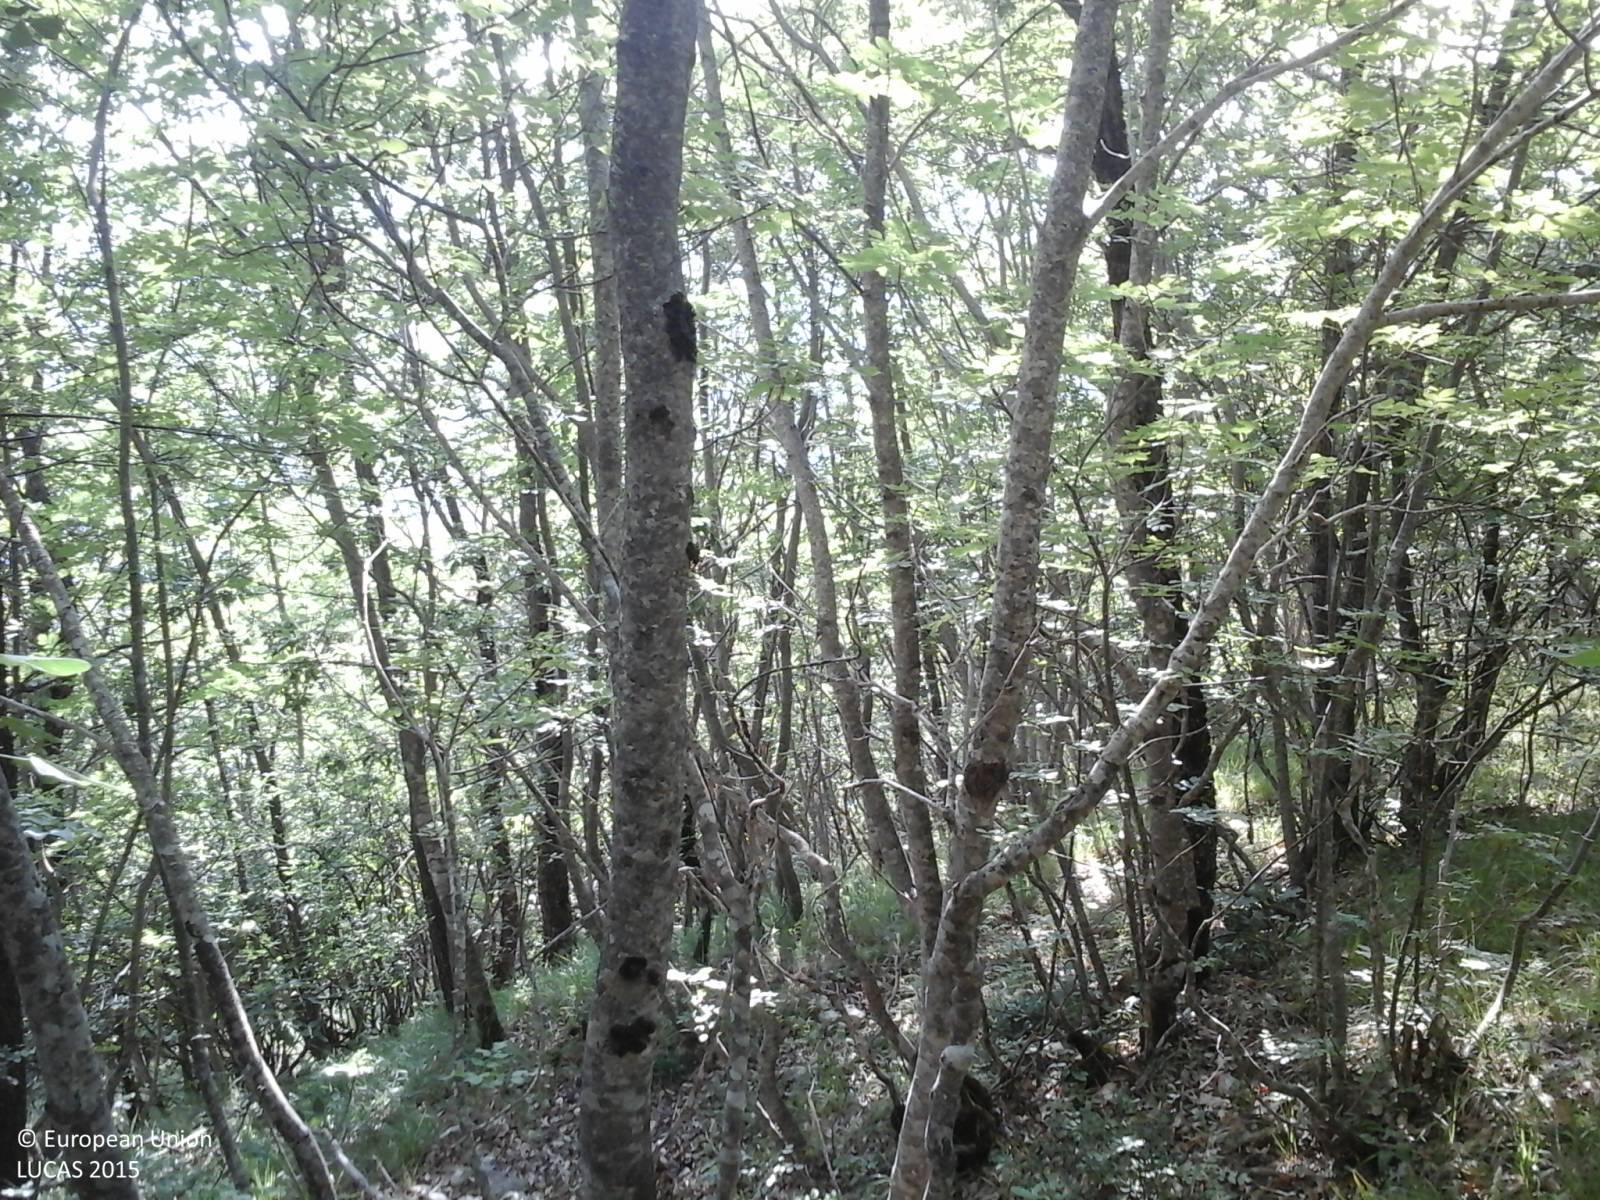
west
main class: Woodland
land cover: Broadleaved woodland
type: thermophilous deciduous forest
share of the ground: > 75 %
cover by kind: broadleaved forest trees 100 %
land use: Forestry
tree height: > 5 m
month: July
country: IT
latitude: 42.4600
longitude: 13.1638
